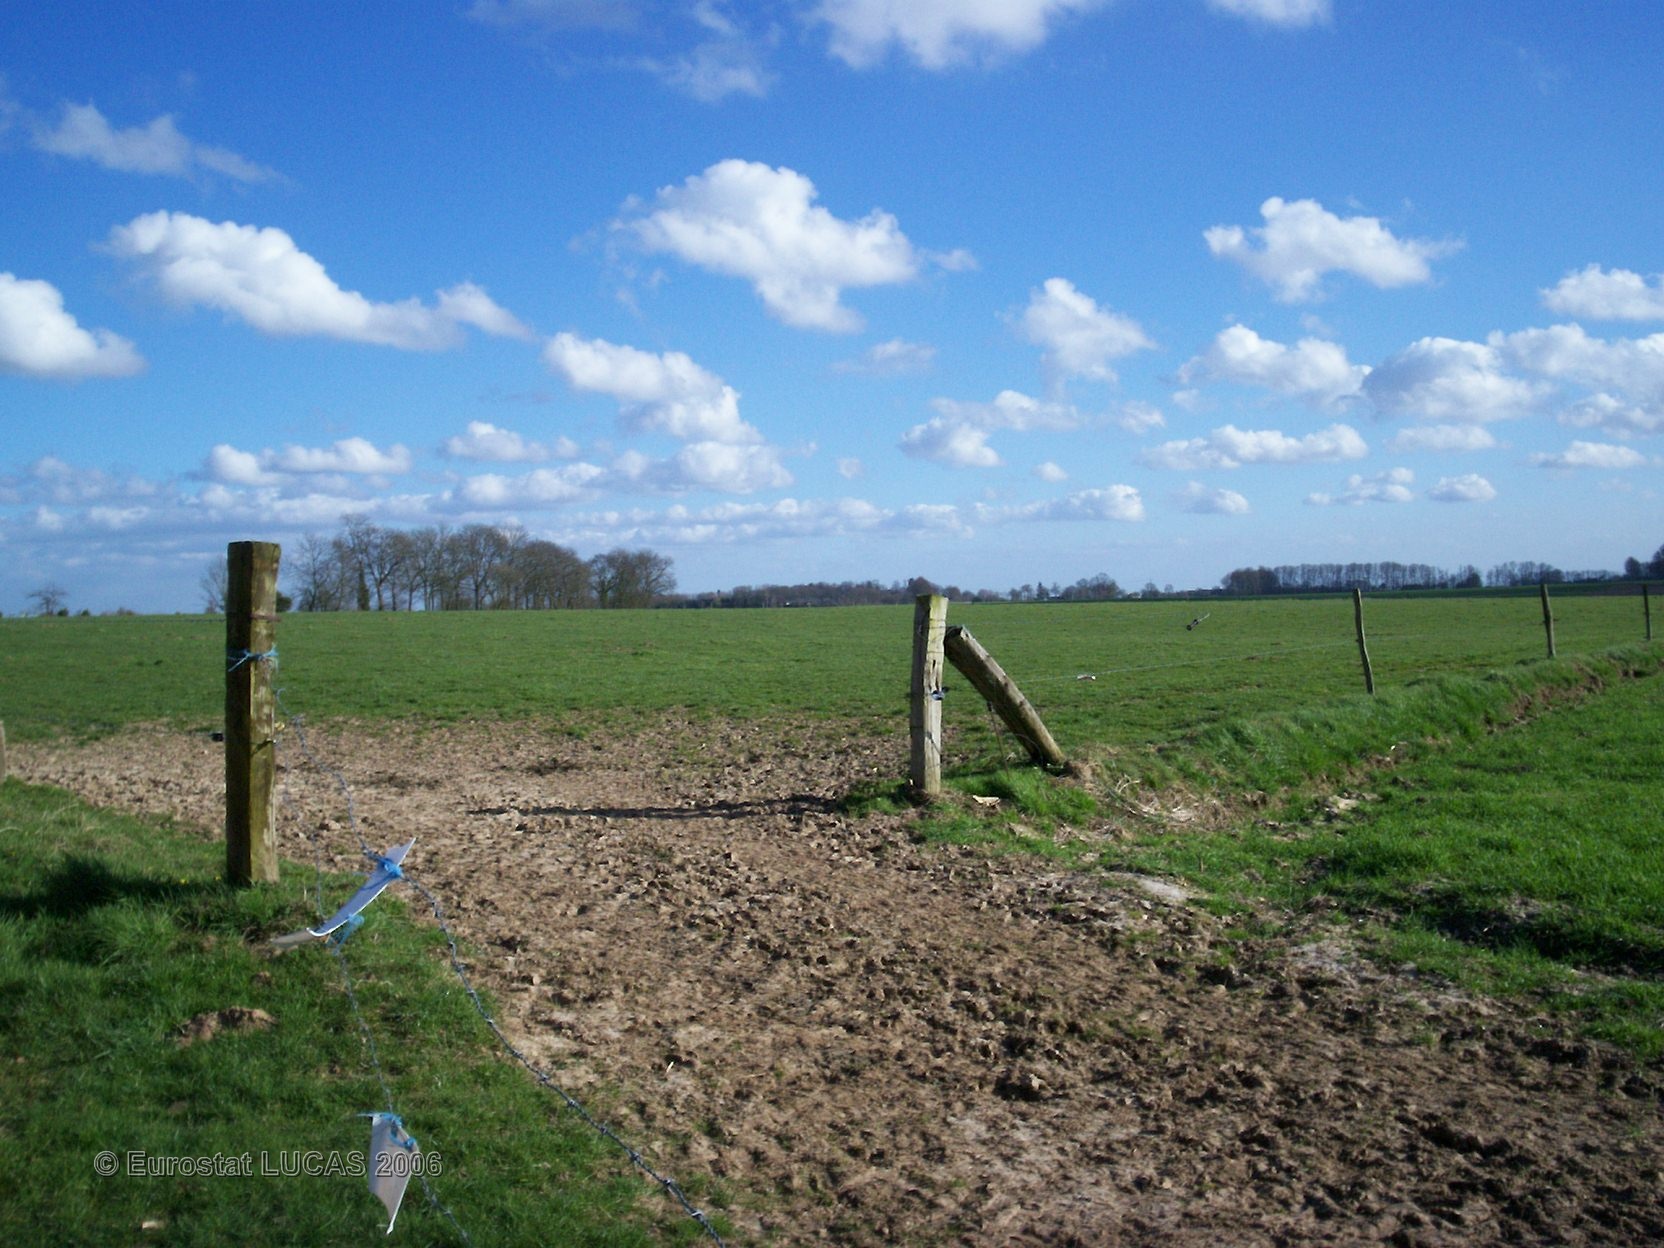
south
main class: Cropland
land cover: Common wheat
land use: Agriculture (excluding fallow land and kitchen gardens)
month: June
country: FR
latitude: 49.6236
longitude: 0.9375
